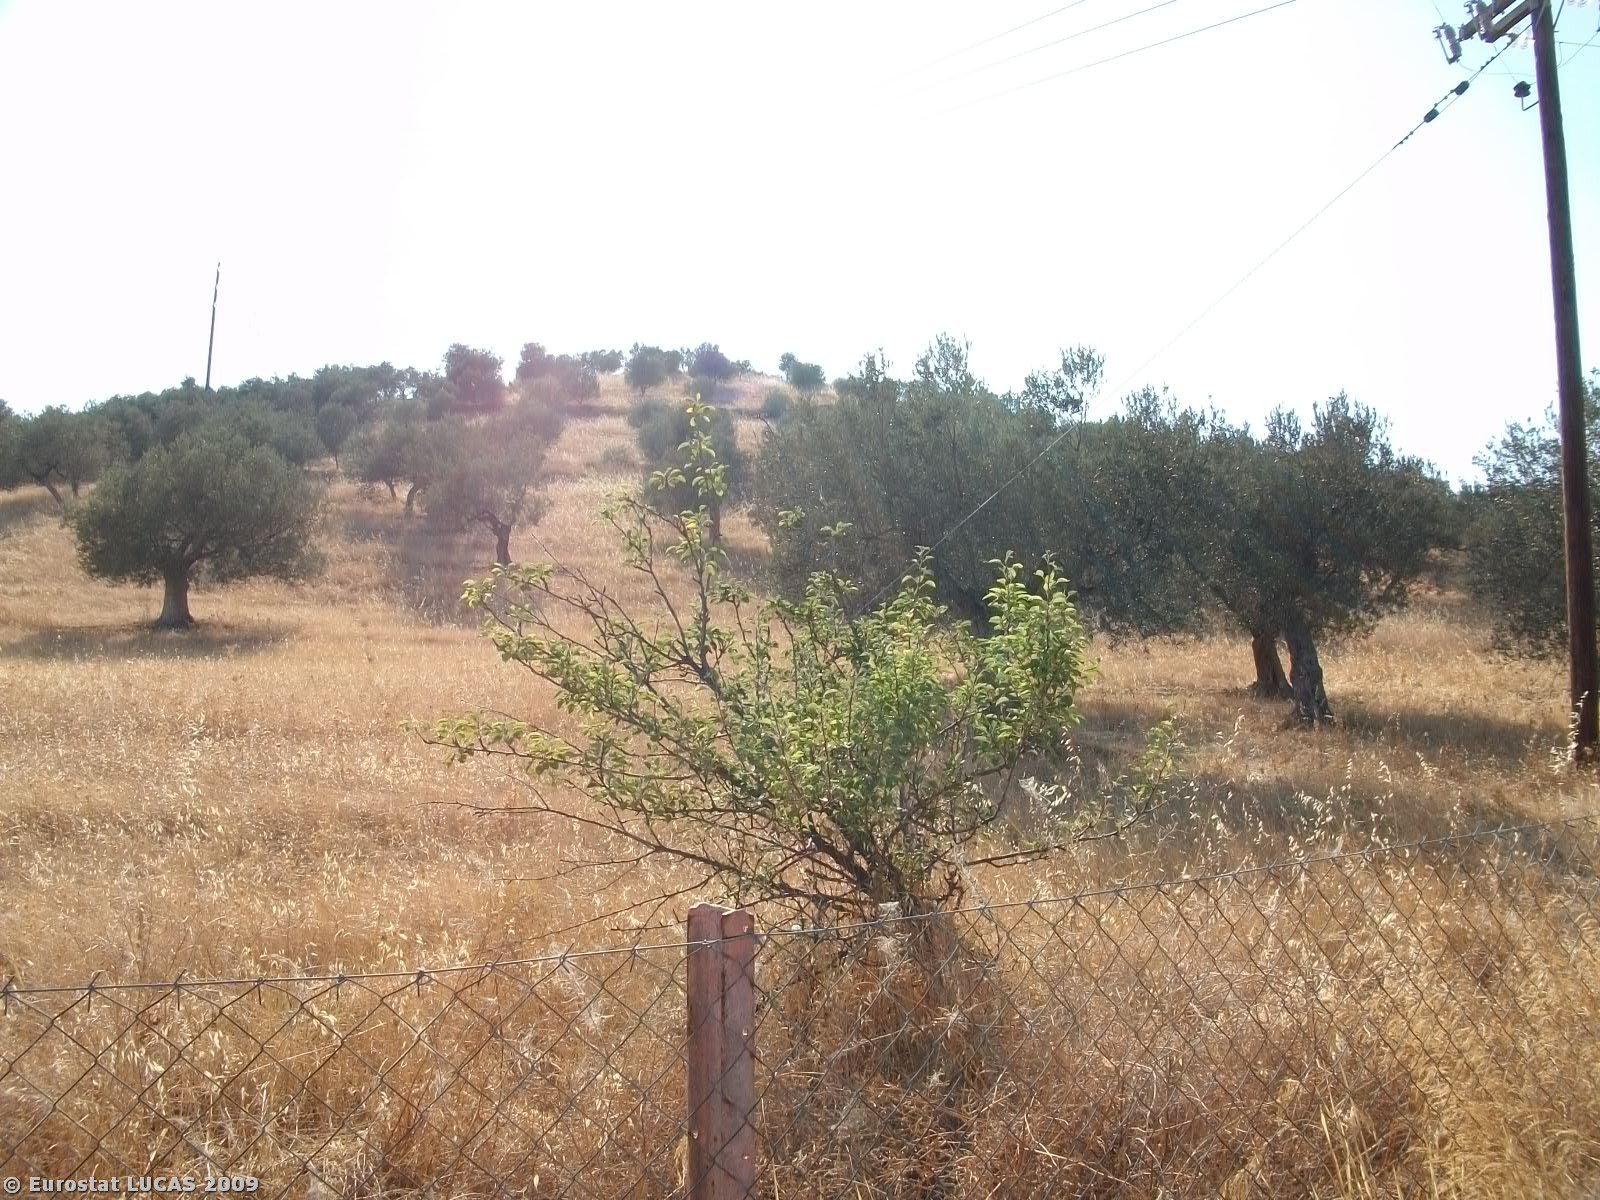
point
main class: Cropland
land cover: Olive groves
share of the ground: 25 - 50 %
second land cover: Grassland with sparse tree/shrub cover
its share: > 75 %
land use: Agriculture (excluding fallow land and kitchen gardens)
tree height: < 5 m
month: August
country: GR
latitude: 37.4128
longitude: 23.3112
